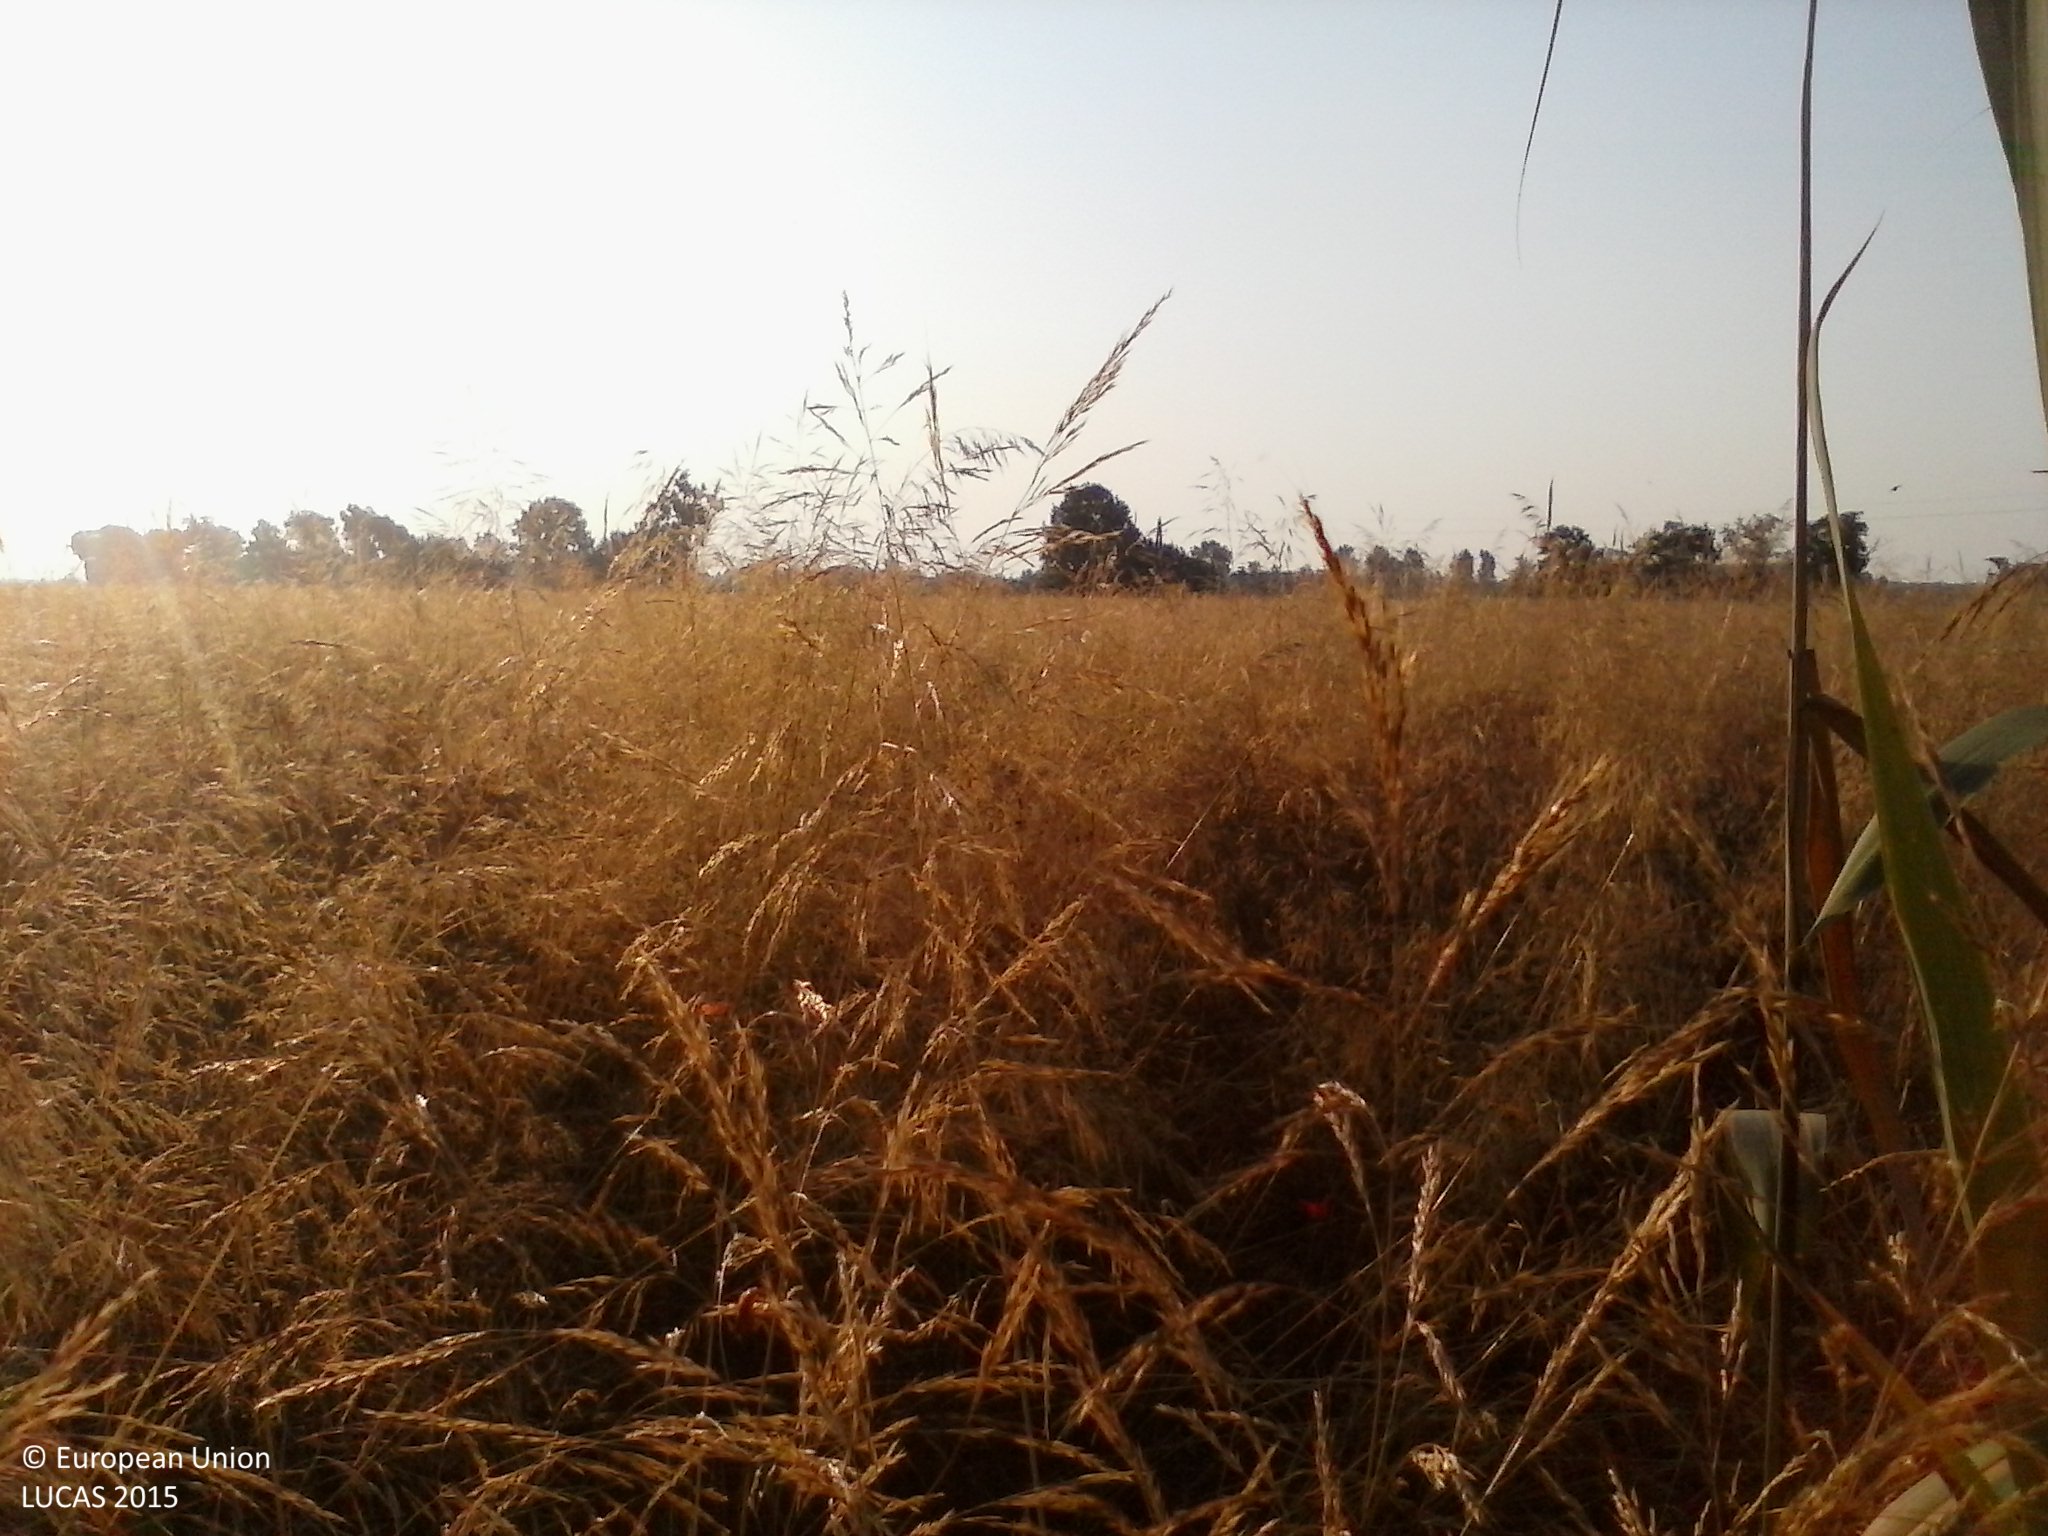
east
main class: Cropland
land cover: Rape and turnip rape
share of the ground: 10 - 25 %
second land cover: Spontaneously vegetated surfaces
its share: > 75 %
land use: Agriculture (excluding fallow land and kitchen gardens)
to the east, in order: Rape and turnip rape; Spontaneously vegetated surfaces
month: July
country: HU
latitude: 46.4324
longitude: 19.5307
